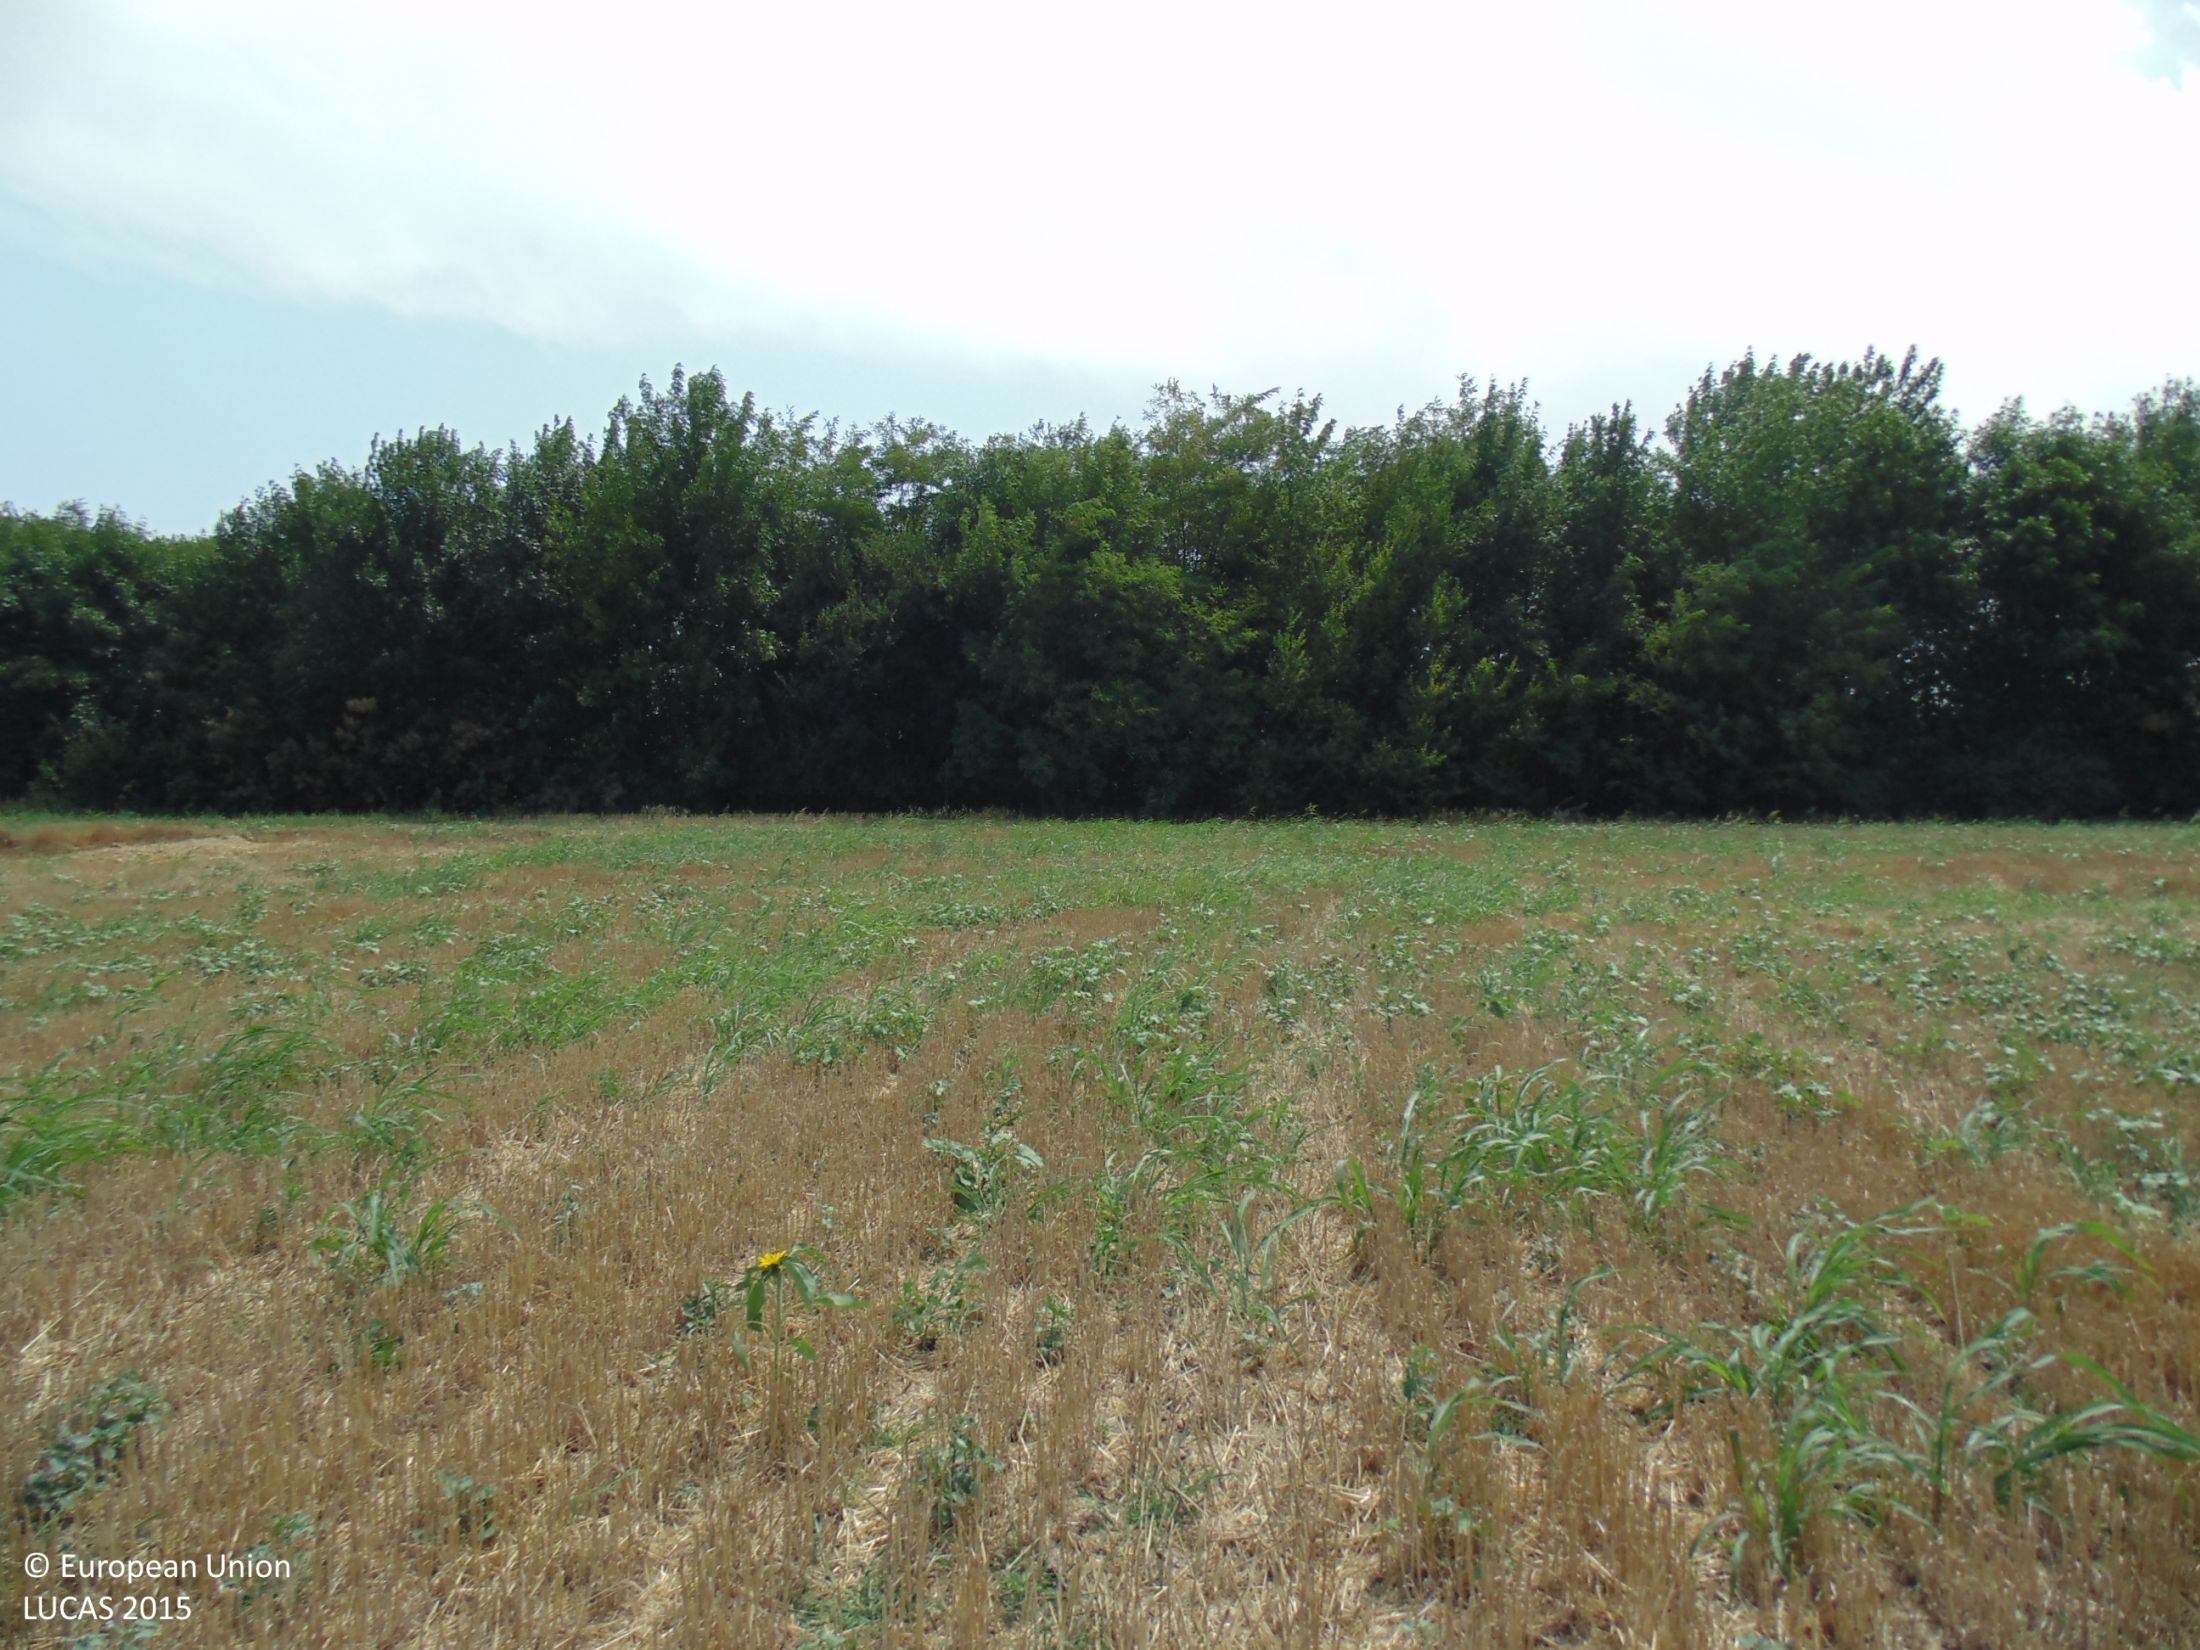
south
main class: Cropland
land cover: Common wheat
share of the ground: 25 - 50 %
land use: Agriculture (excluding fallow land and kitchen gardens)
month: August
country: BG
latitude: 43.7443
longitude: 28.1720
